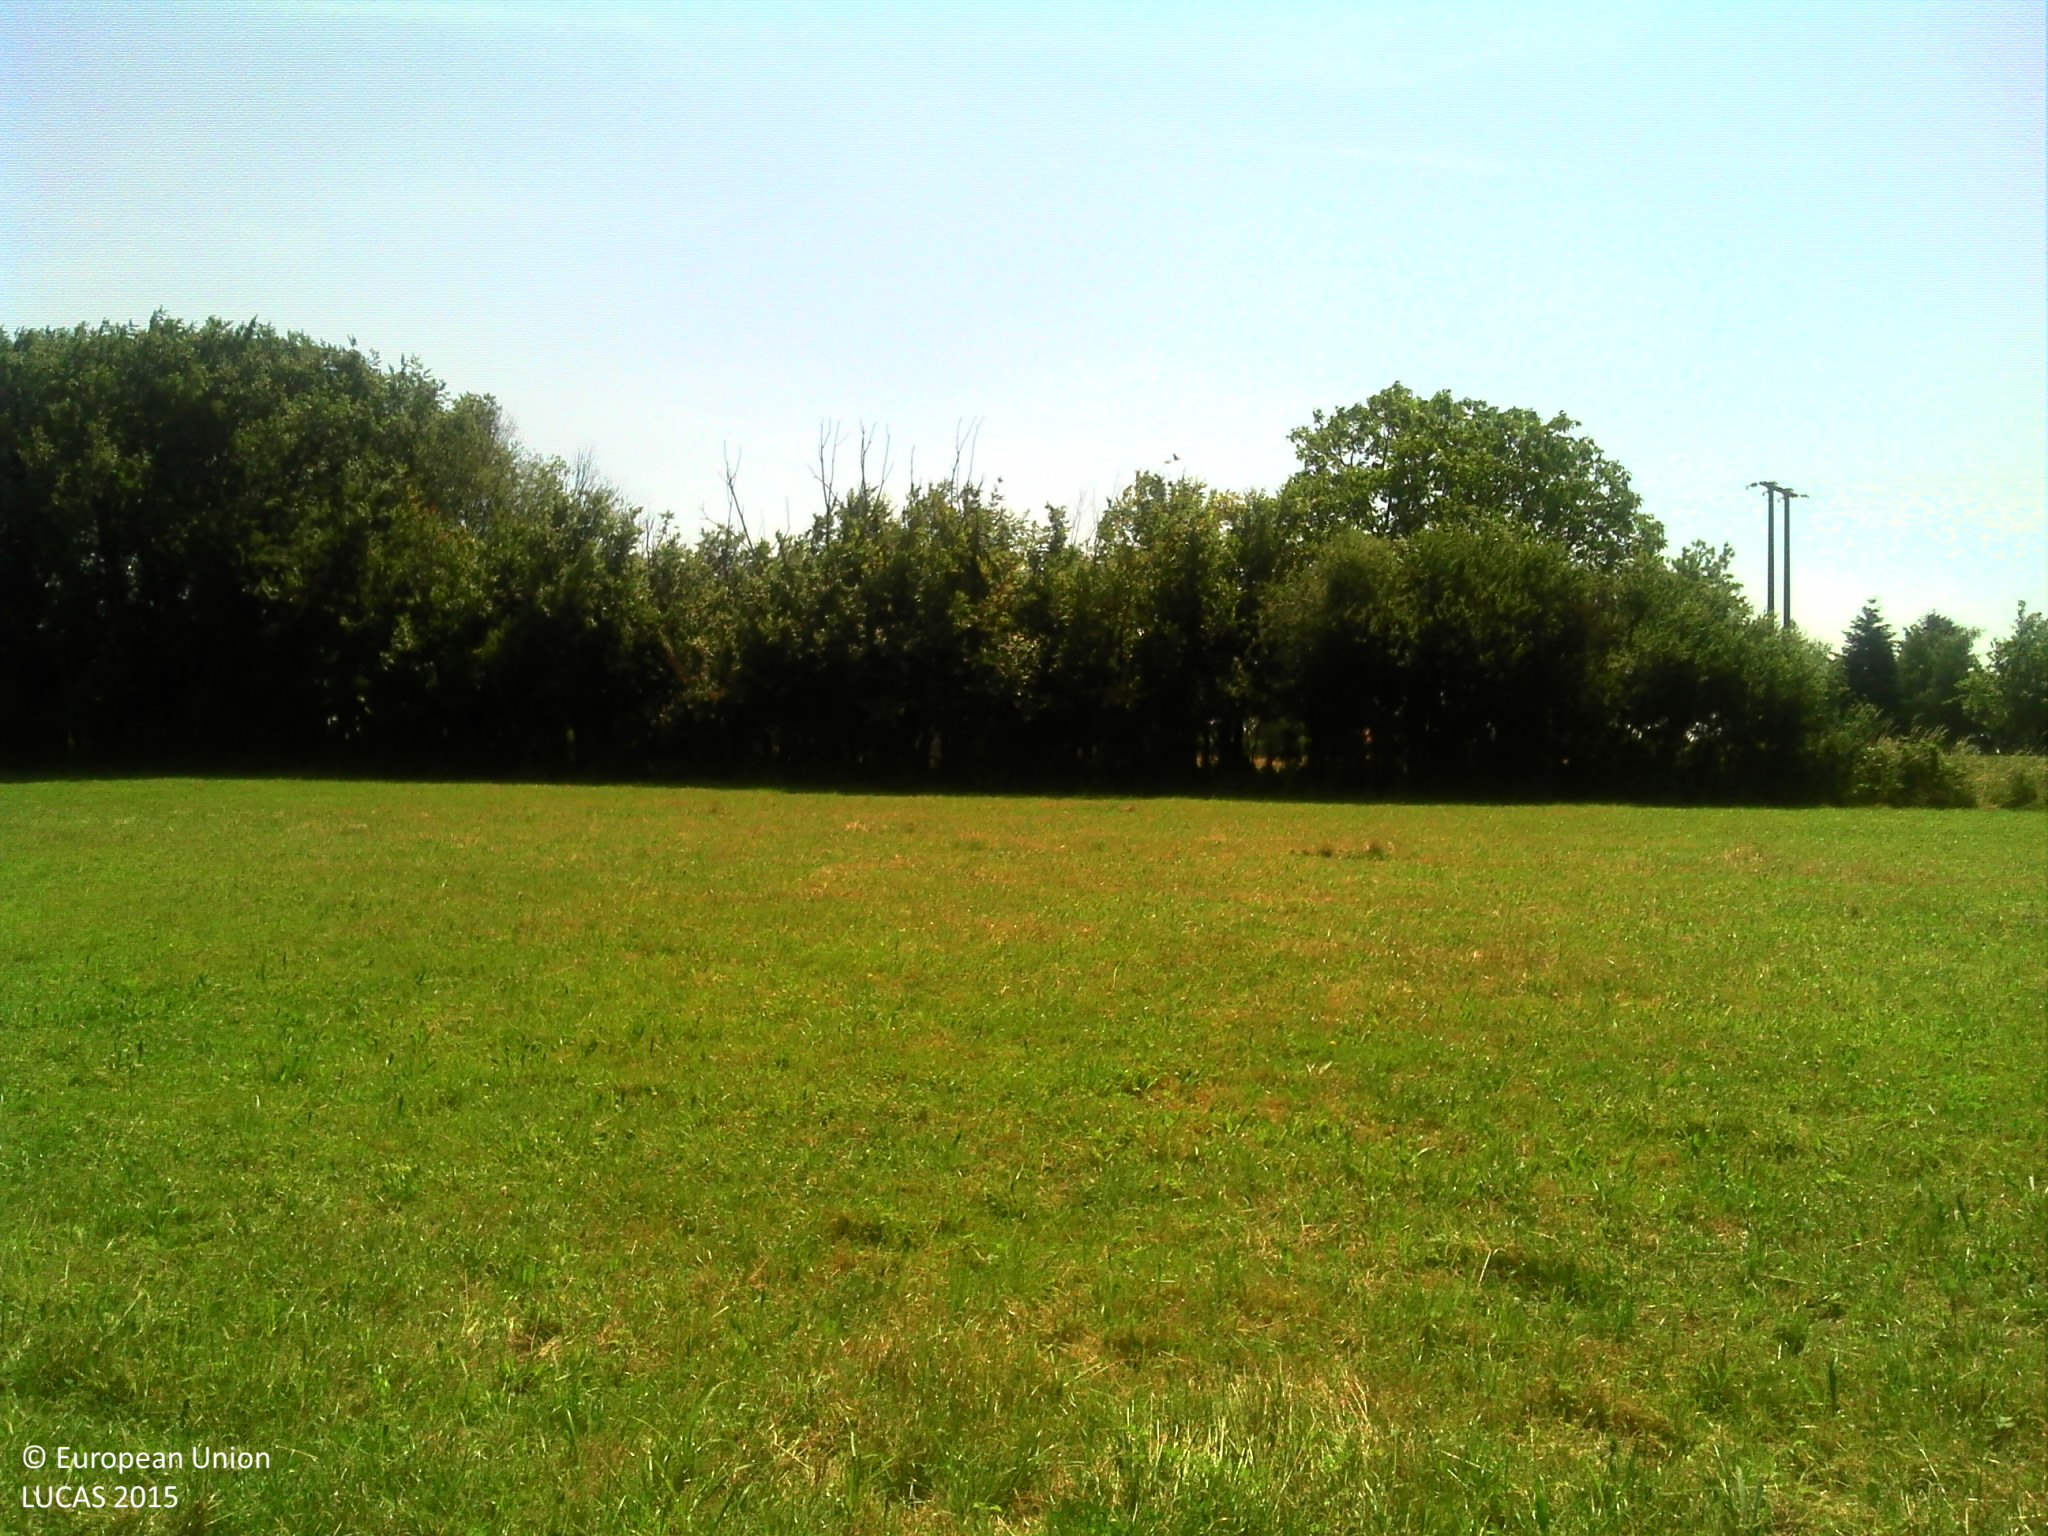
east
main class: Grassland
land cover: Grassland with sparse tree/shrub cover
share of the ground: > 75 %
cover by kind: herbaceous plants 90 %, broadleaved forest trees 5 %, shrubs 5 %
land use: Agriculture (excluding fallow land and kitchen gardens)
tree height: > 5 m
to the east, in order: Grassland with sparse tree/shrub cover; Grassland without tree/shrub cover; Lines of trees; Fences; Lines of trees; Fences; Grassland without tree/shrub cover; Fences; Grassland without tree/shrub cover; Electric lines; Grassland without tree/shrub cover; Fences; Lines of trees; Other leguminous and mixtures for fodder
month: June
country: FR
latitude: 47.0945
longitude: 5.2717
